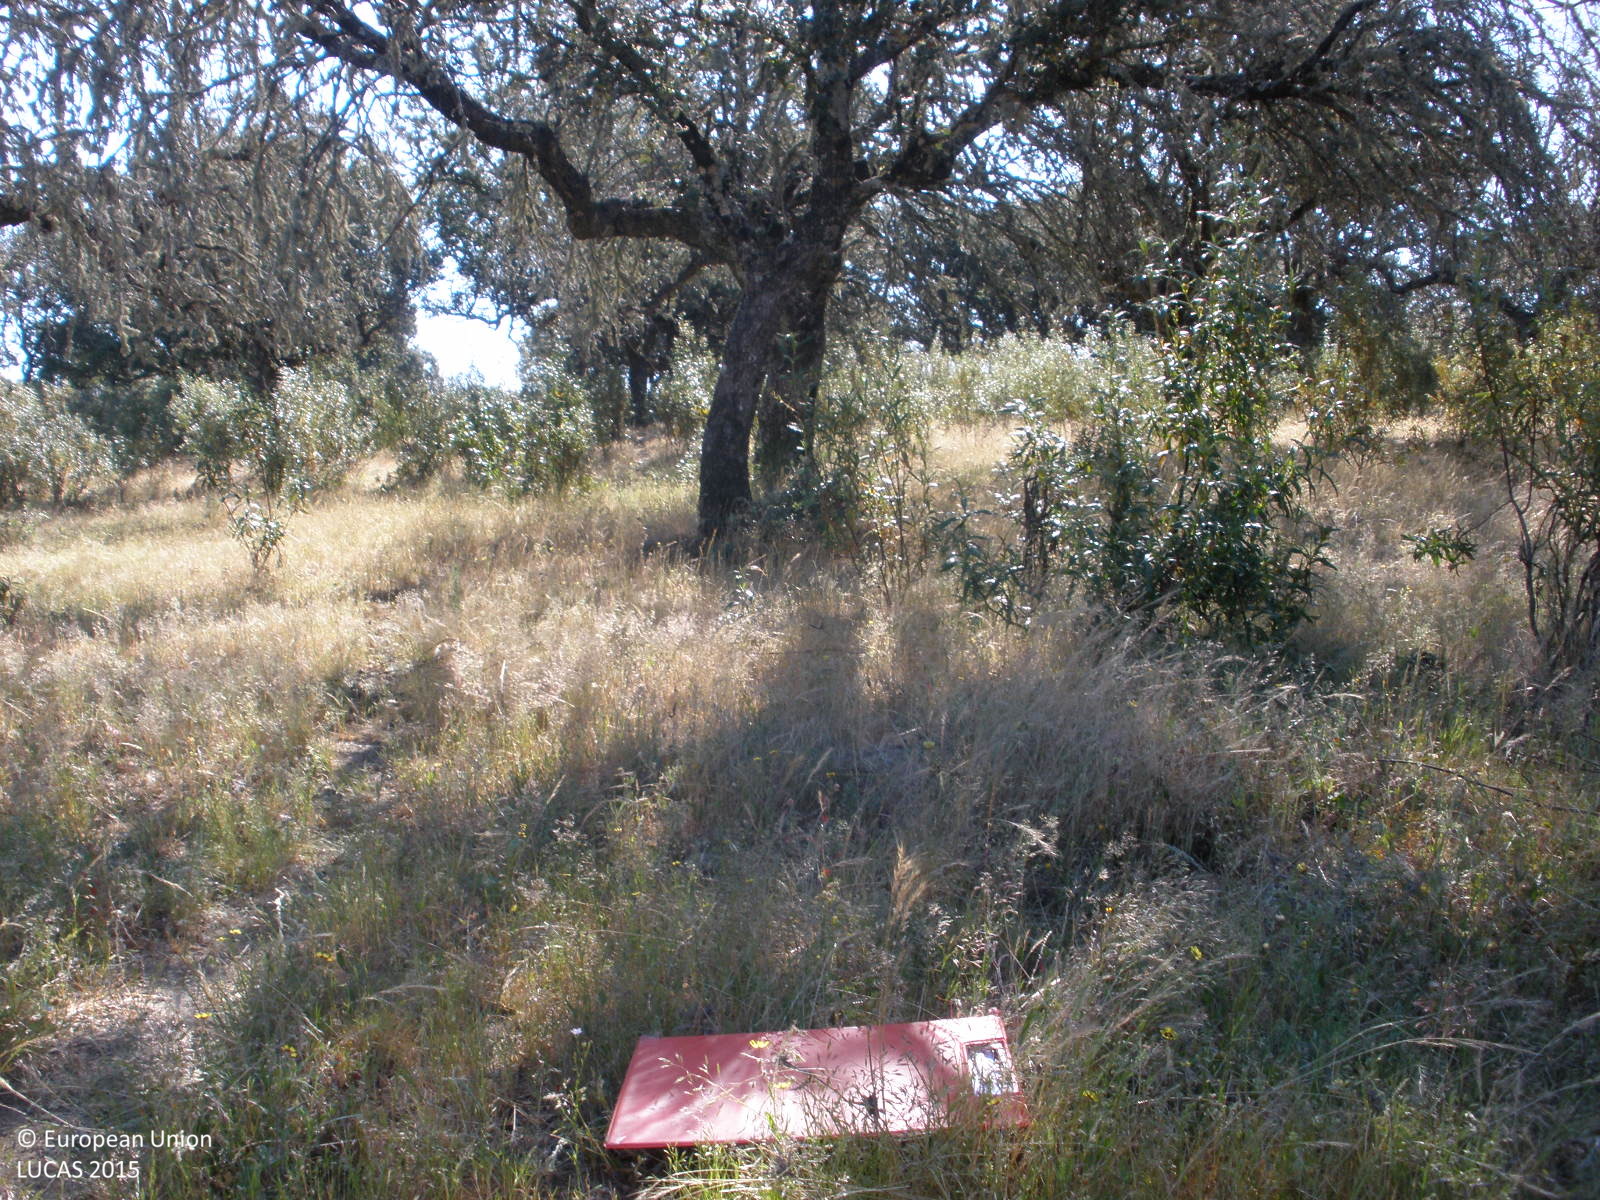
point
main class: Woodland
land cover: Broadleaved woodland
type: broadleaved evergreen forest
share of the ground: 50 - 75 %
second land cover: Grassland without tree/shrub cover
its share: > 75 %
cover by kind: herbaceous plants 60 %, broadleaved forest trees 35 %, shrubs 5 %
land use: Forestry
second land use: Agriculture (excluding fallow land and kitchen gardens)
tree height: < 5 m
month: May
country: ES
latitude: 40.2260
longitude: -6.2607
